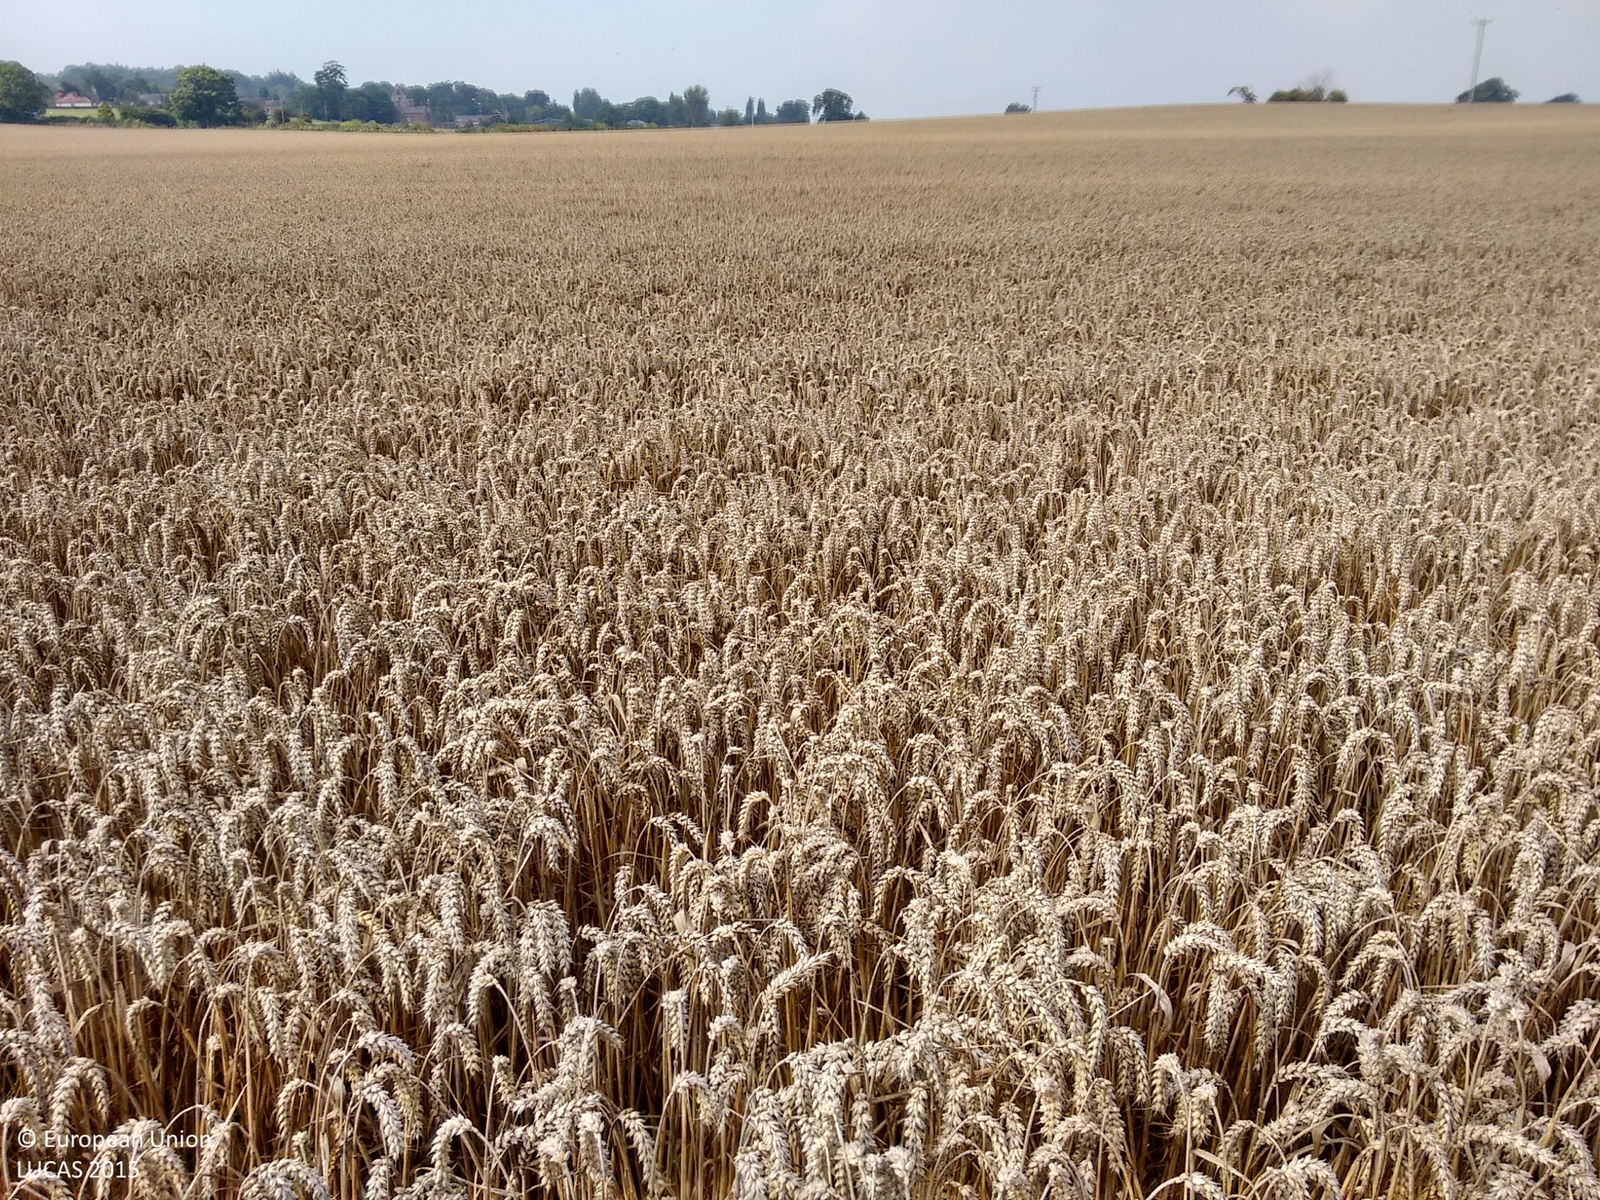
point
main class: Cropland
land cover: Common wheat
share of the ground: > 75 %
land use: Agriculture (excluding fallow land and kitchen gardens)
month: September
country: GB
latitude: 52.7221
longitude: -2.9398
